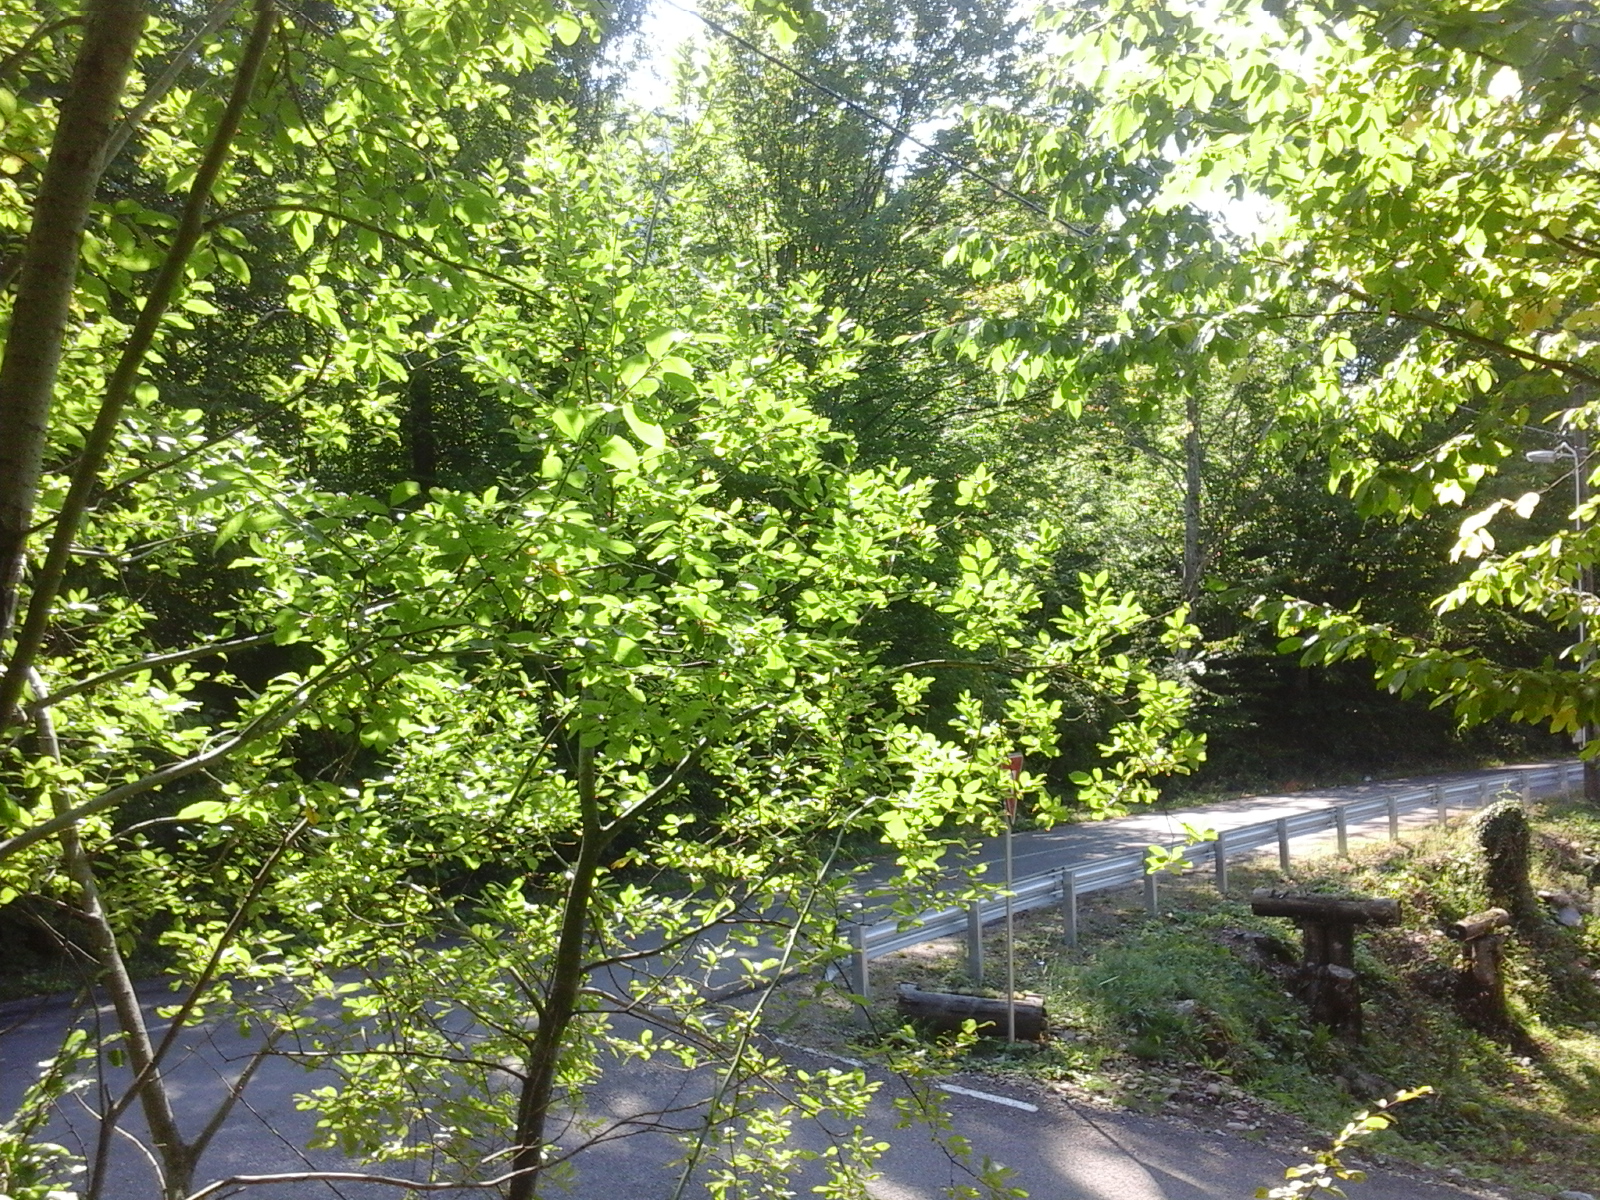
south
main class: Woodland
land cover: Broadleaved woodland
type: beech forest
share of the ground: > 75 %
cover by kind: broadleaved forest trees 100 %
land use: Forestry
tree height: > 5 m
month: September
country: RO
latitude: 46.5986
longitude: 22.6513
